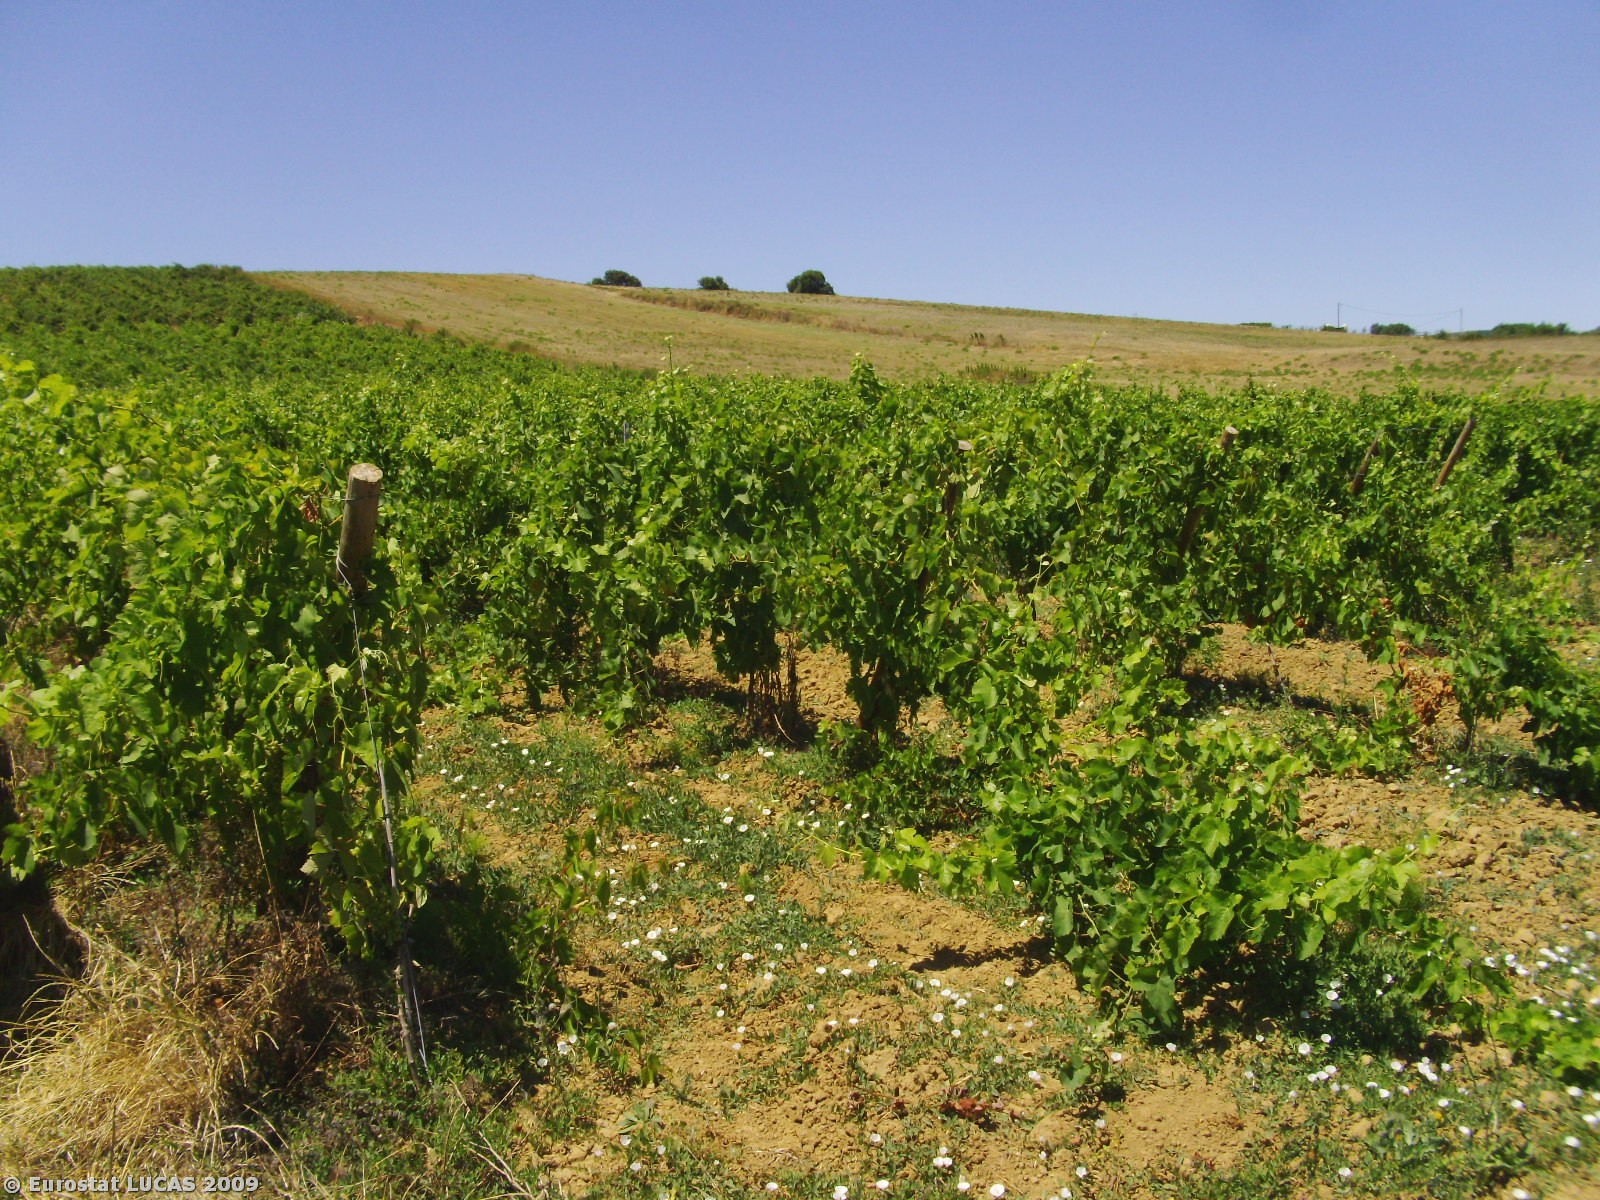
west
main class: Grassland
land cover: Spontaneously vegetated surfaces
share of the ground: 50 - 75 %
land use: Fallow land
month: July
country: PT
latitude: 39.1375
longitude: -9.0664
